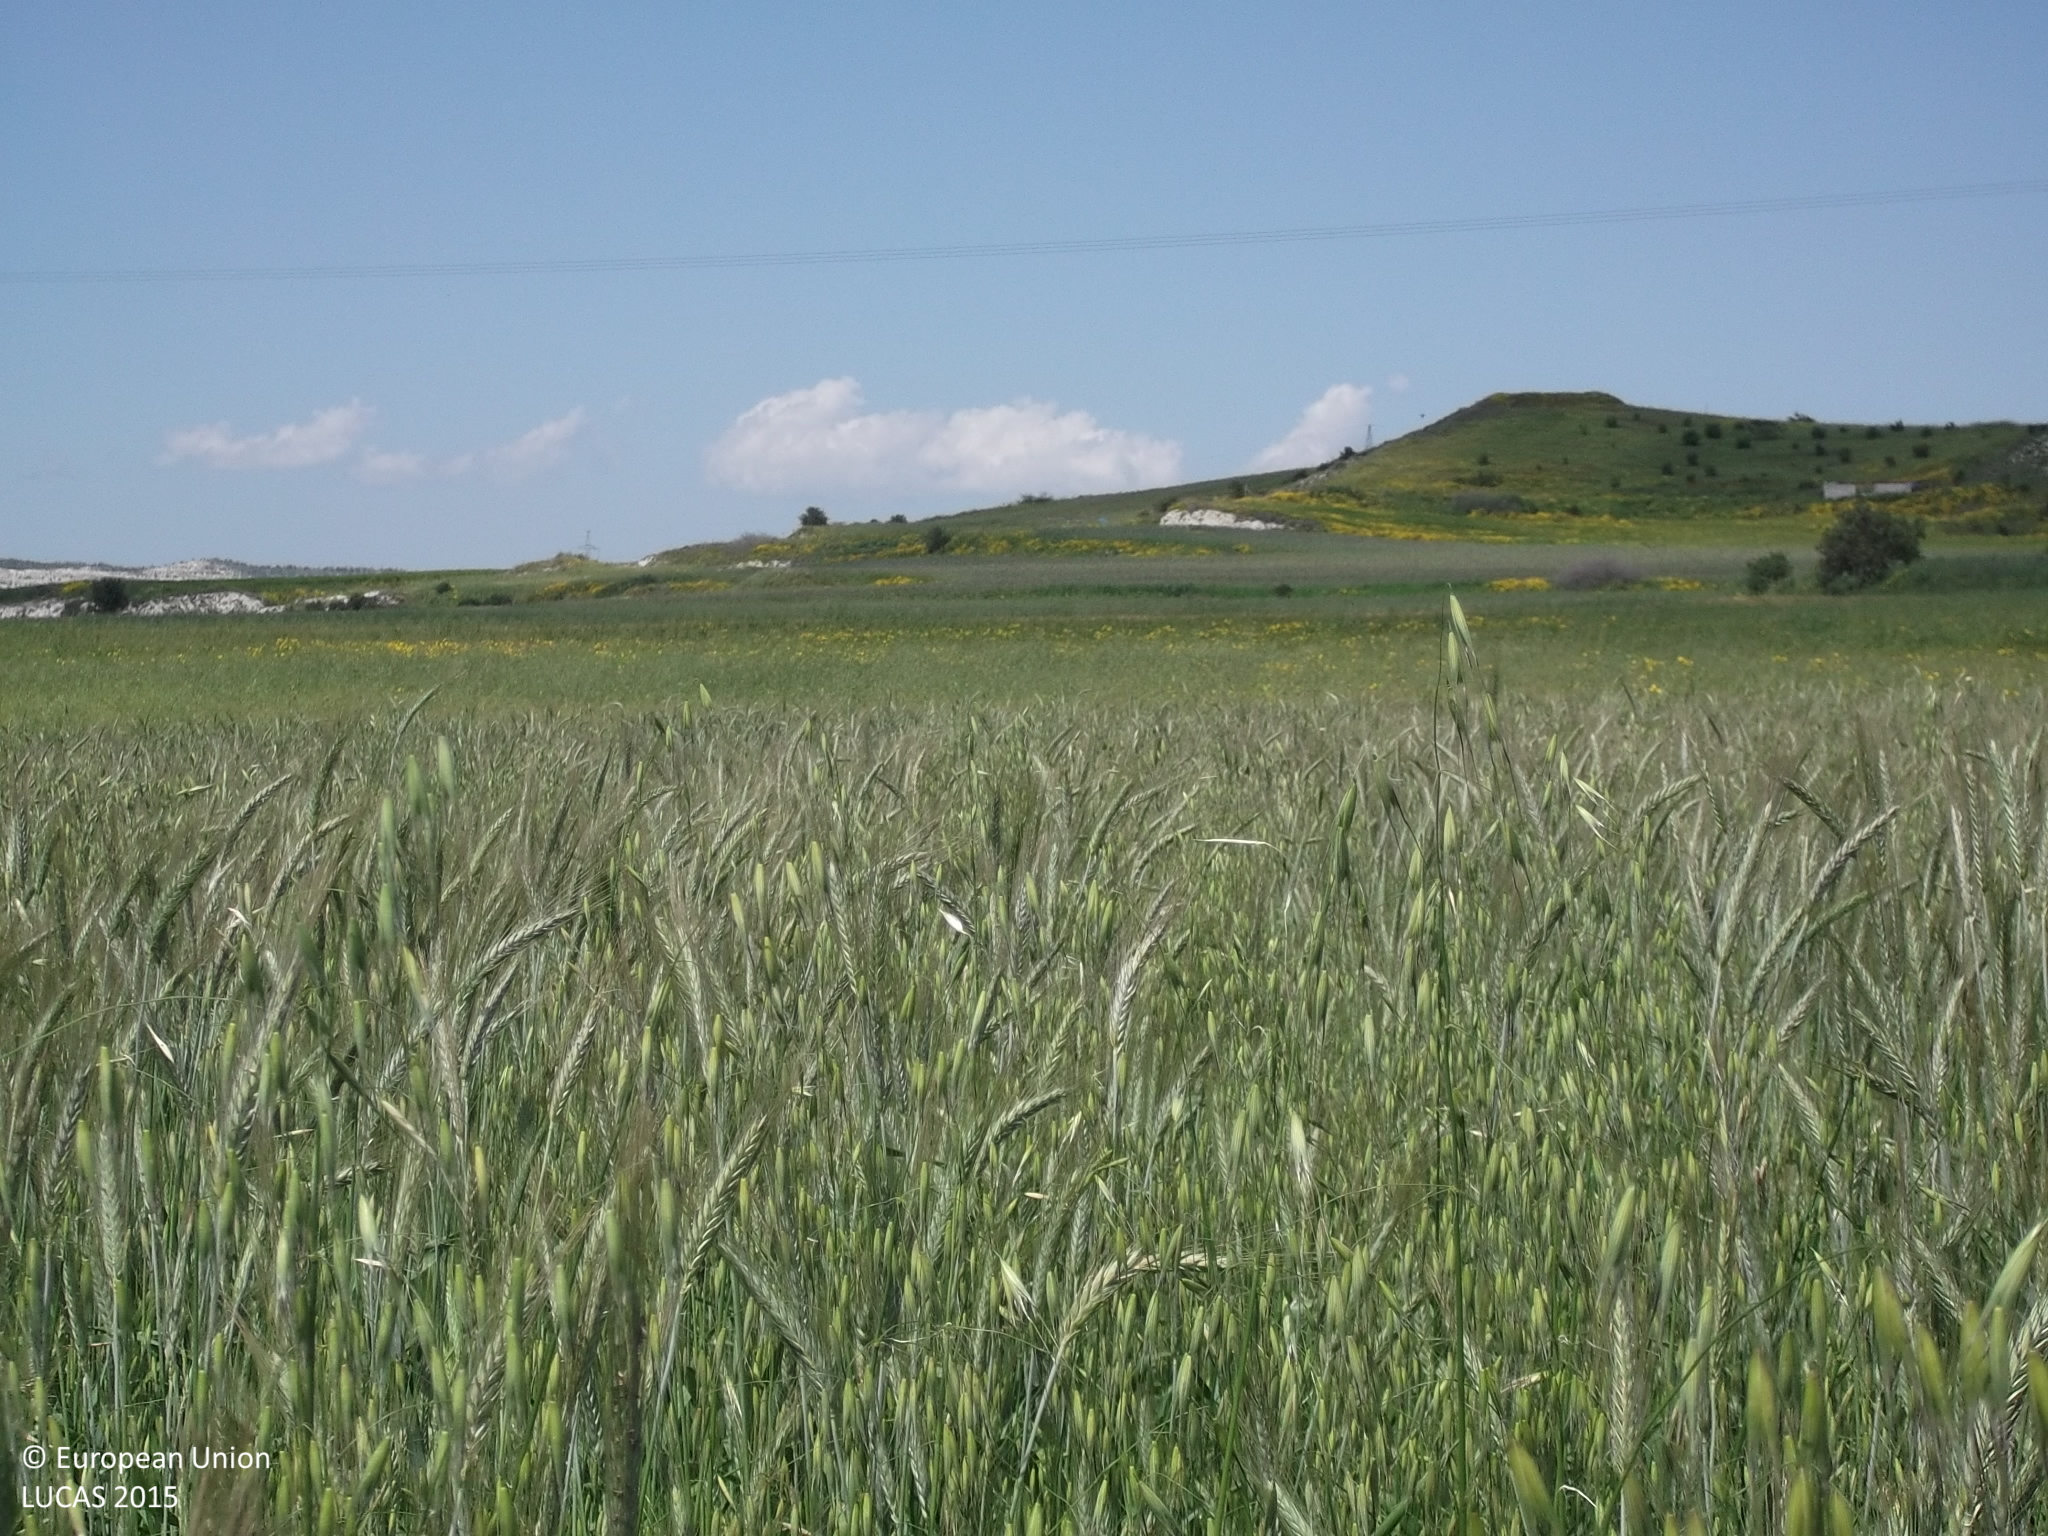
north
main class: Cropland
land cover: Common wheat
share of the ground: > 75 %
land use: Agriculture (excluding fallow land and kitchen gardens)
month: April
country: CY
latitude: 34.8997
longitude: 33.5342
